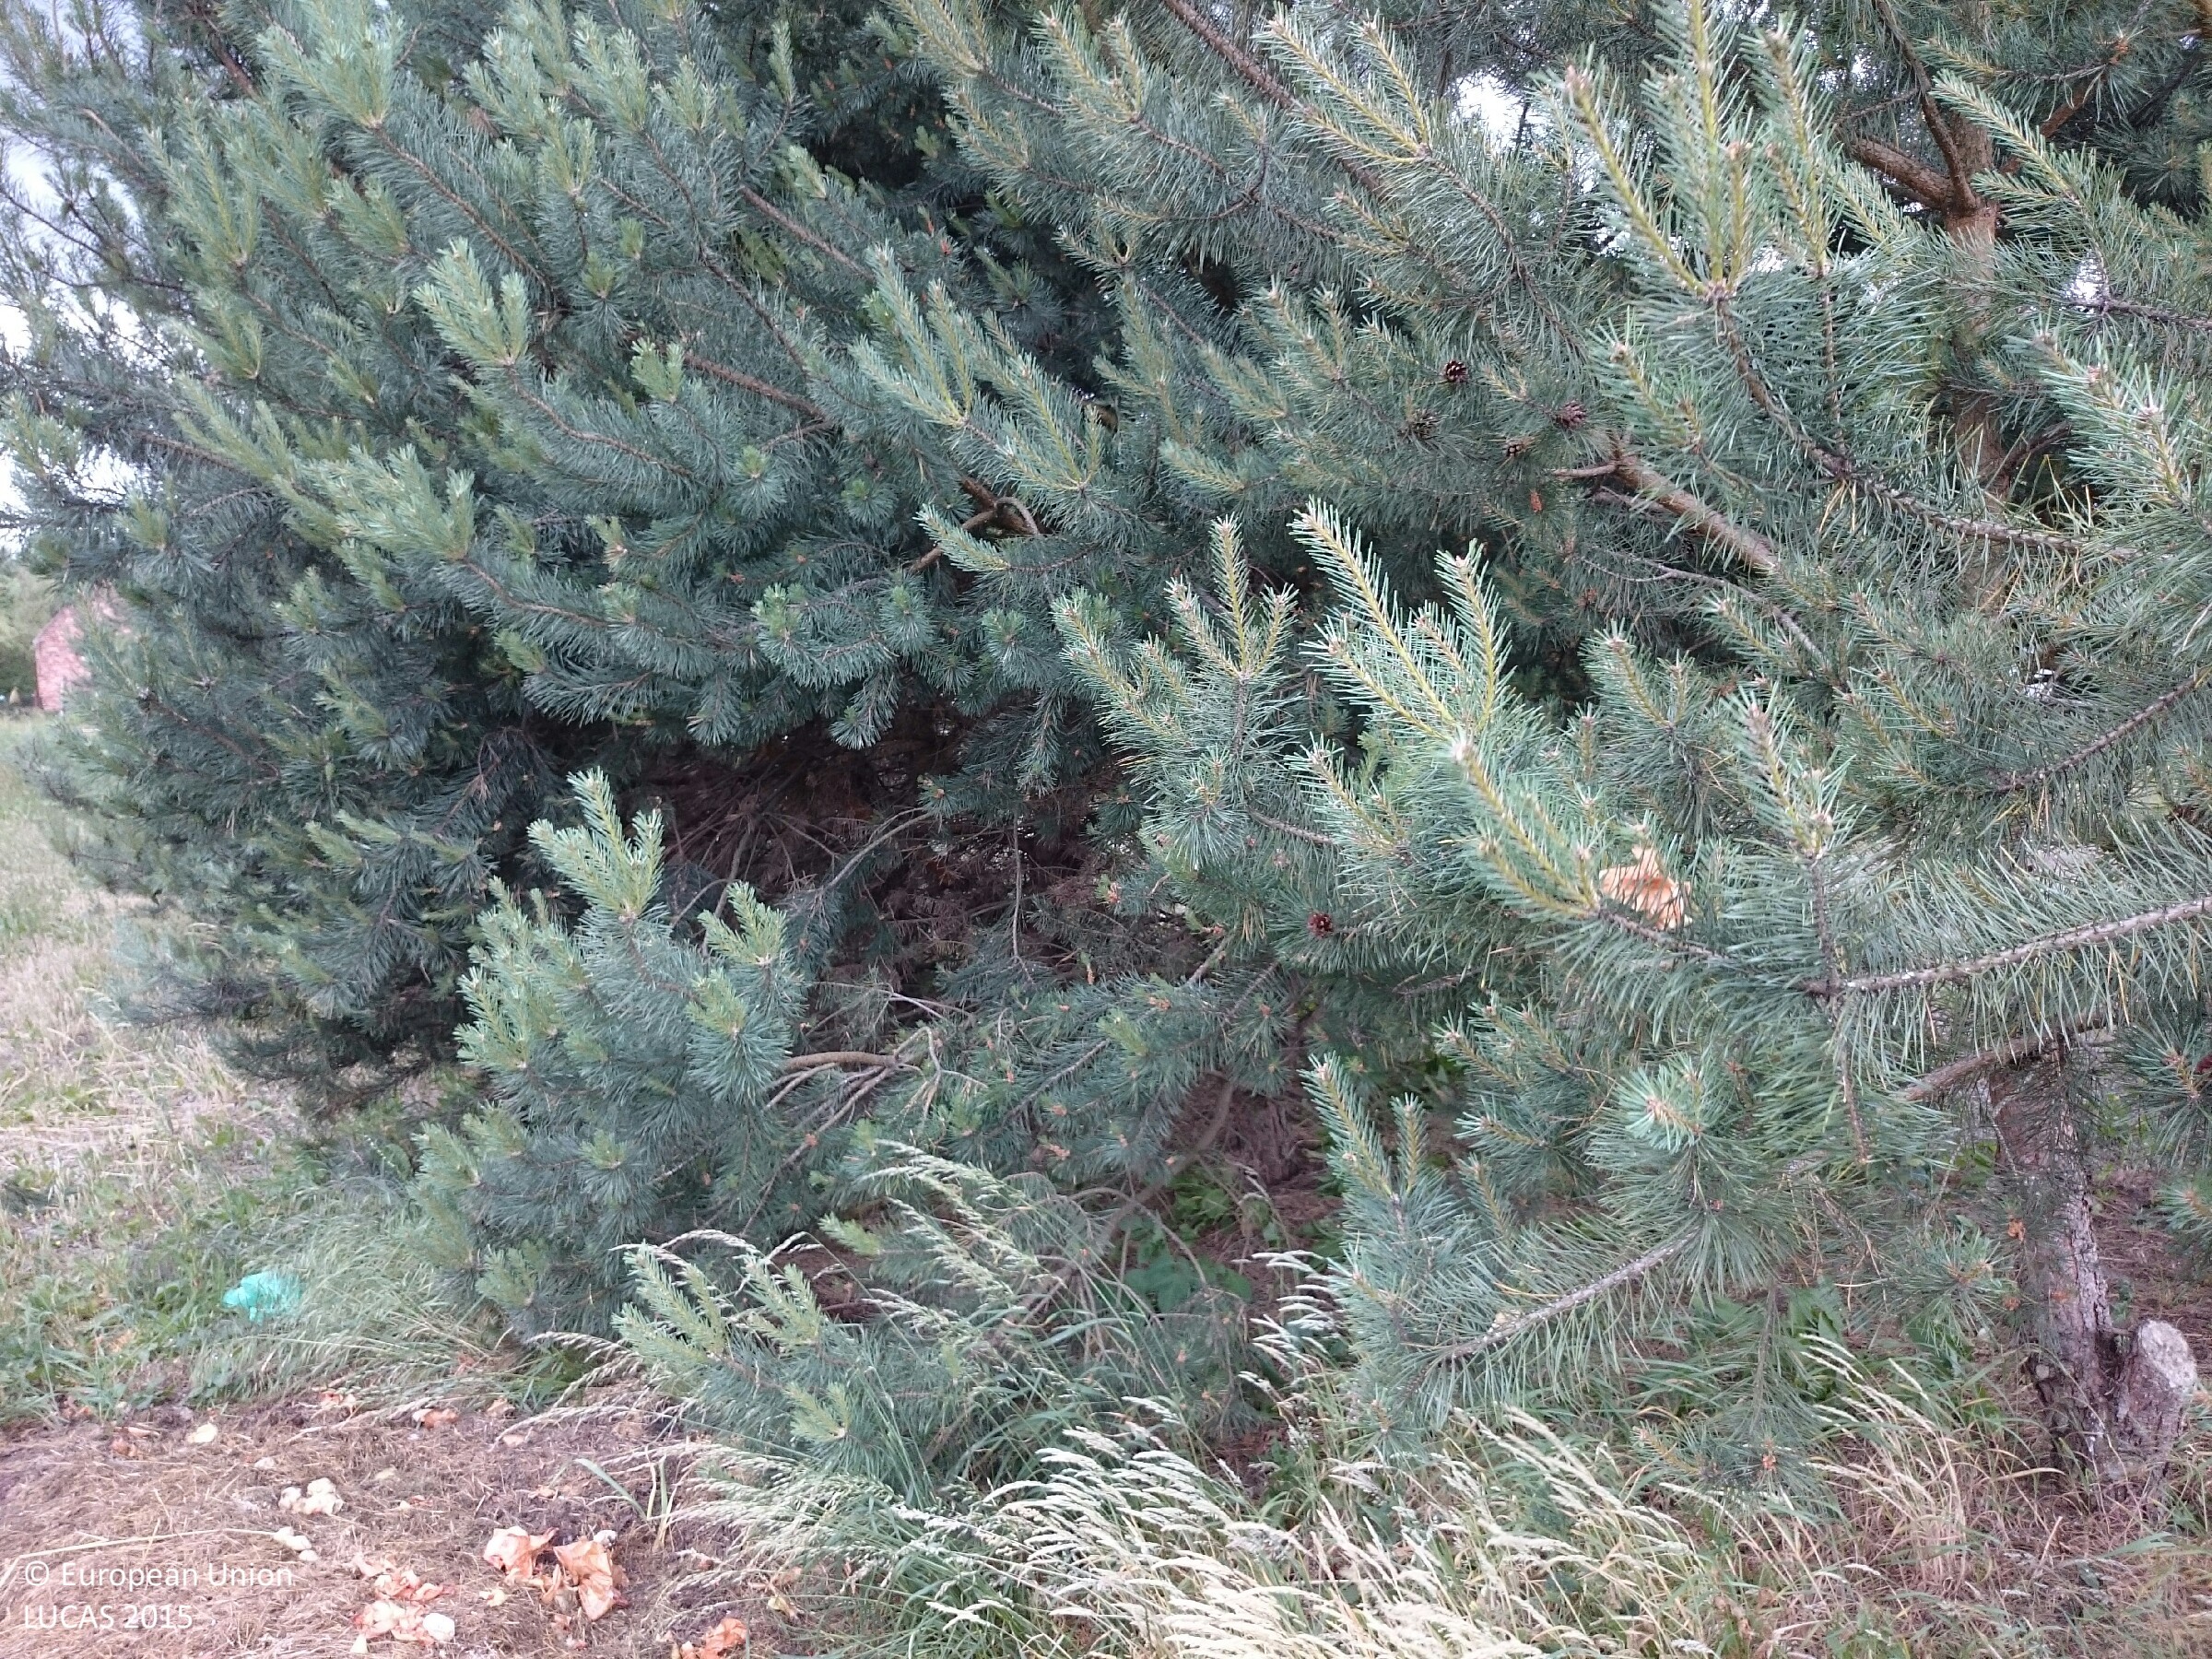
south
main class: Grassland
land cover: Spontaneously vegetated surfaces
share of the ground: > 75 %
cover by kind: herbaceous plants 95 %, shrubs 5 %
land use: Fallow land
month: June
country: PL
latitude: 52.8537
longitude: 15.6920
